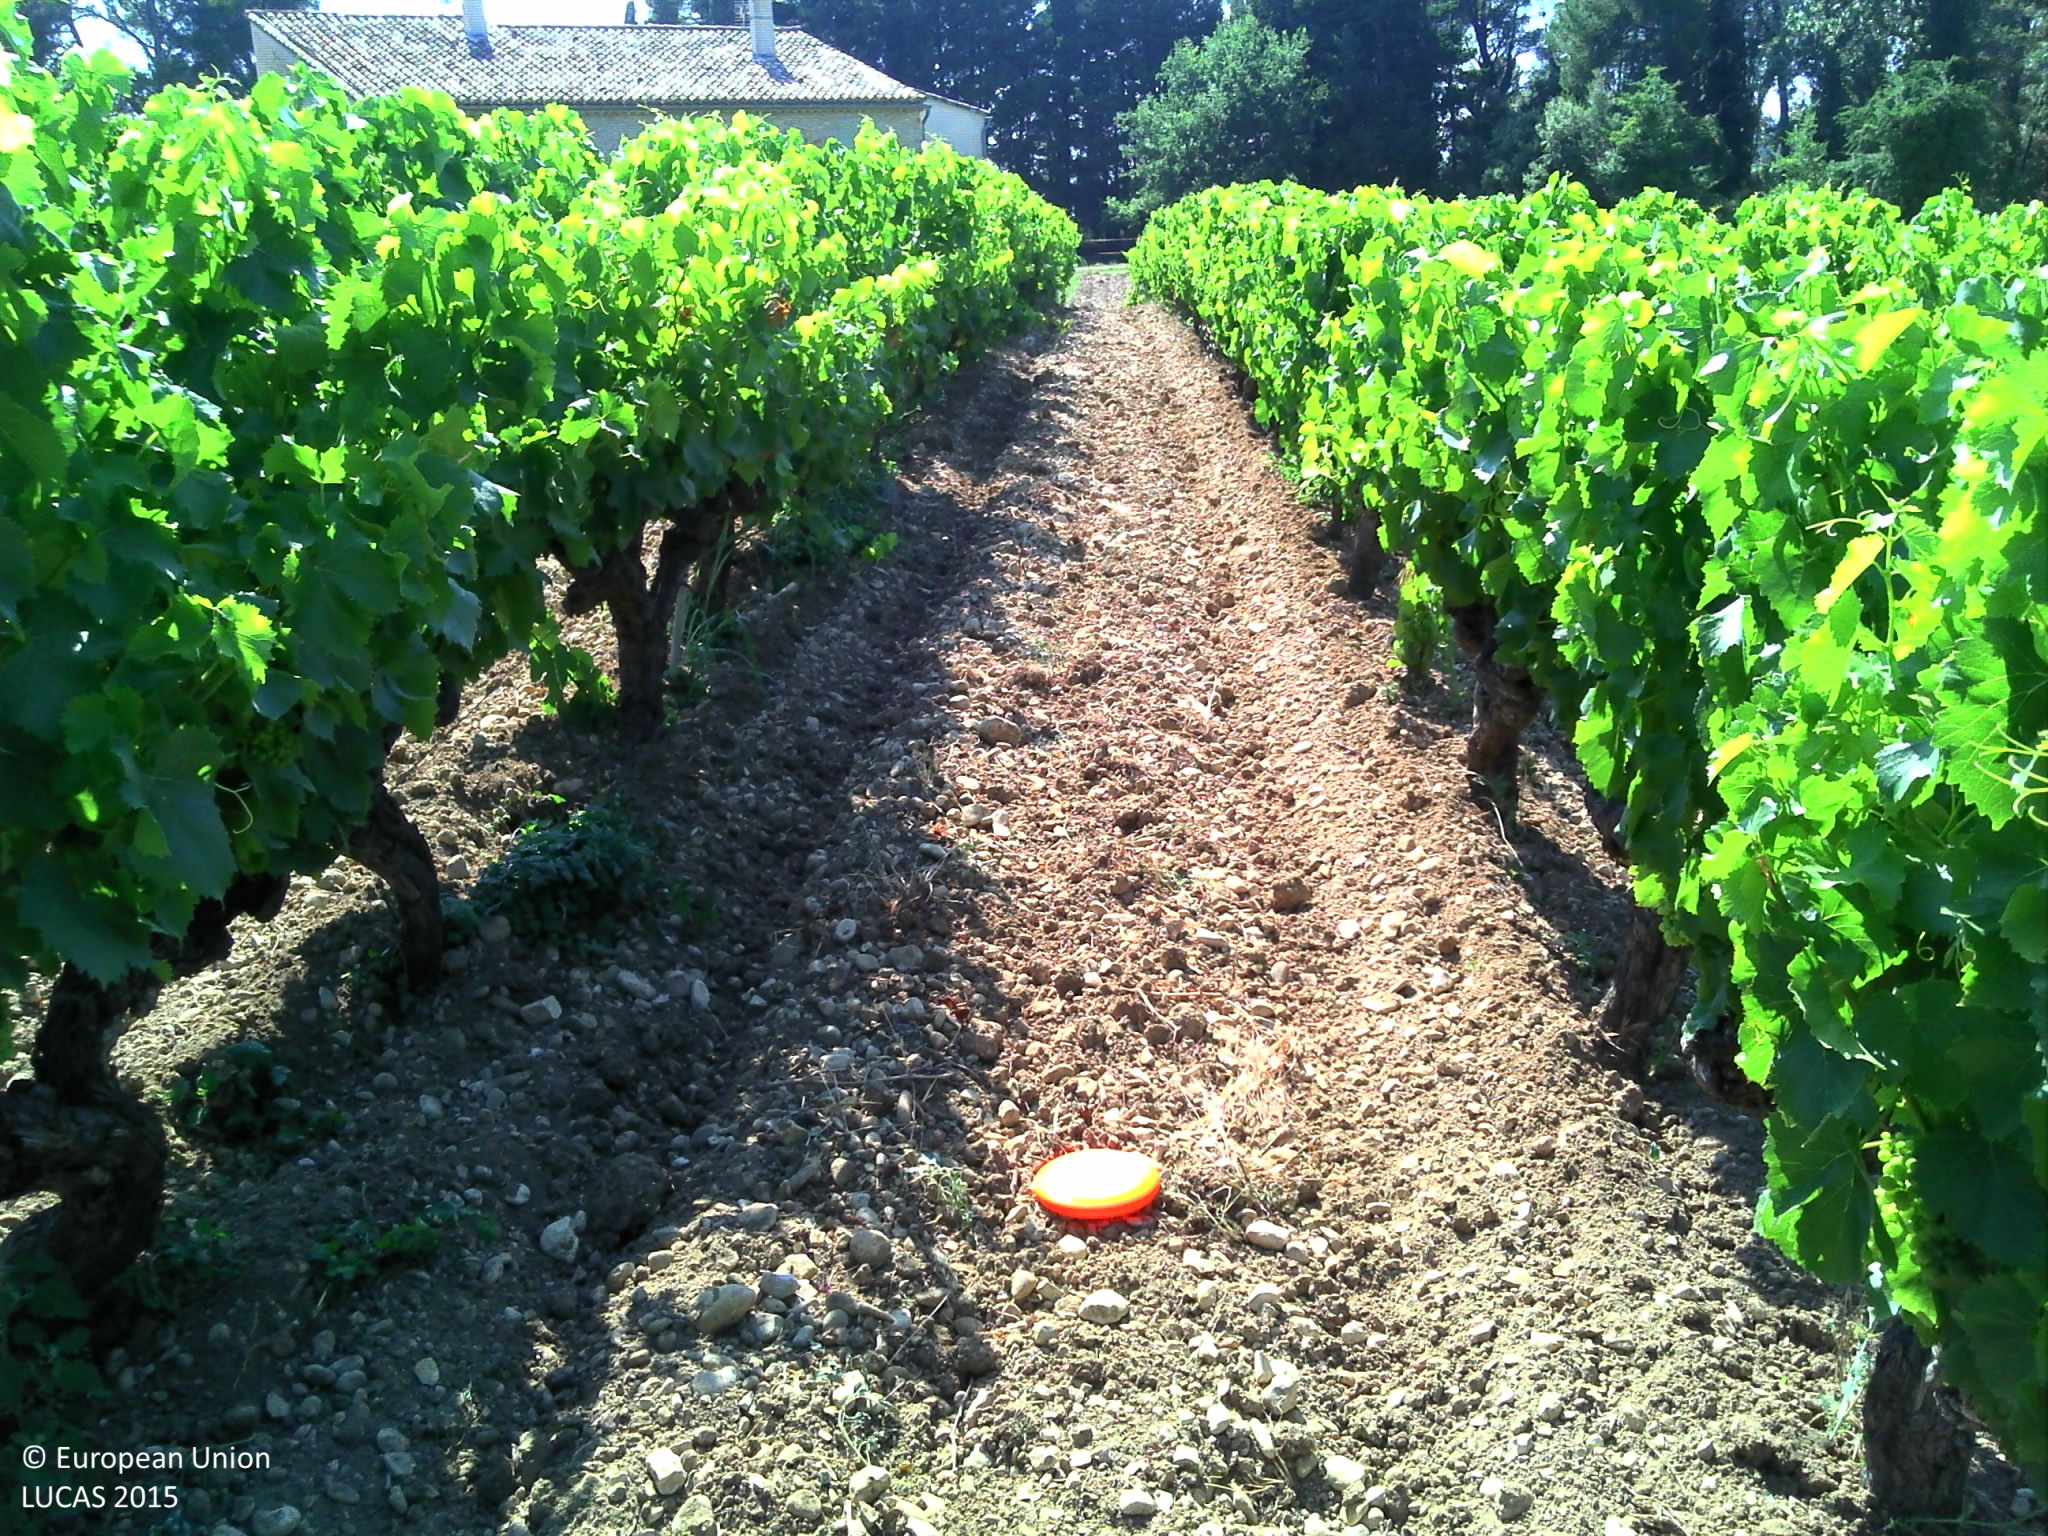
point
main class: Cropland
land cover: Vineyards
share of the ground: > 75 %
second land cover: Other bare soil
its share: > 75 %
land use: Agriculture (excluding fallow land and kitchen gardens)
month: June
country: FR
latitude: 44.2870
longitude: 5.0577
